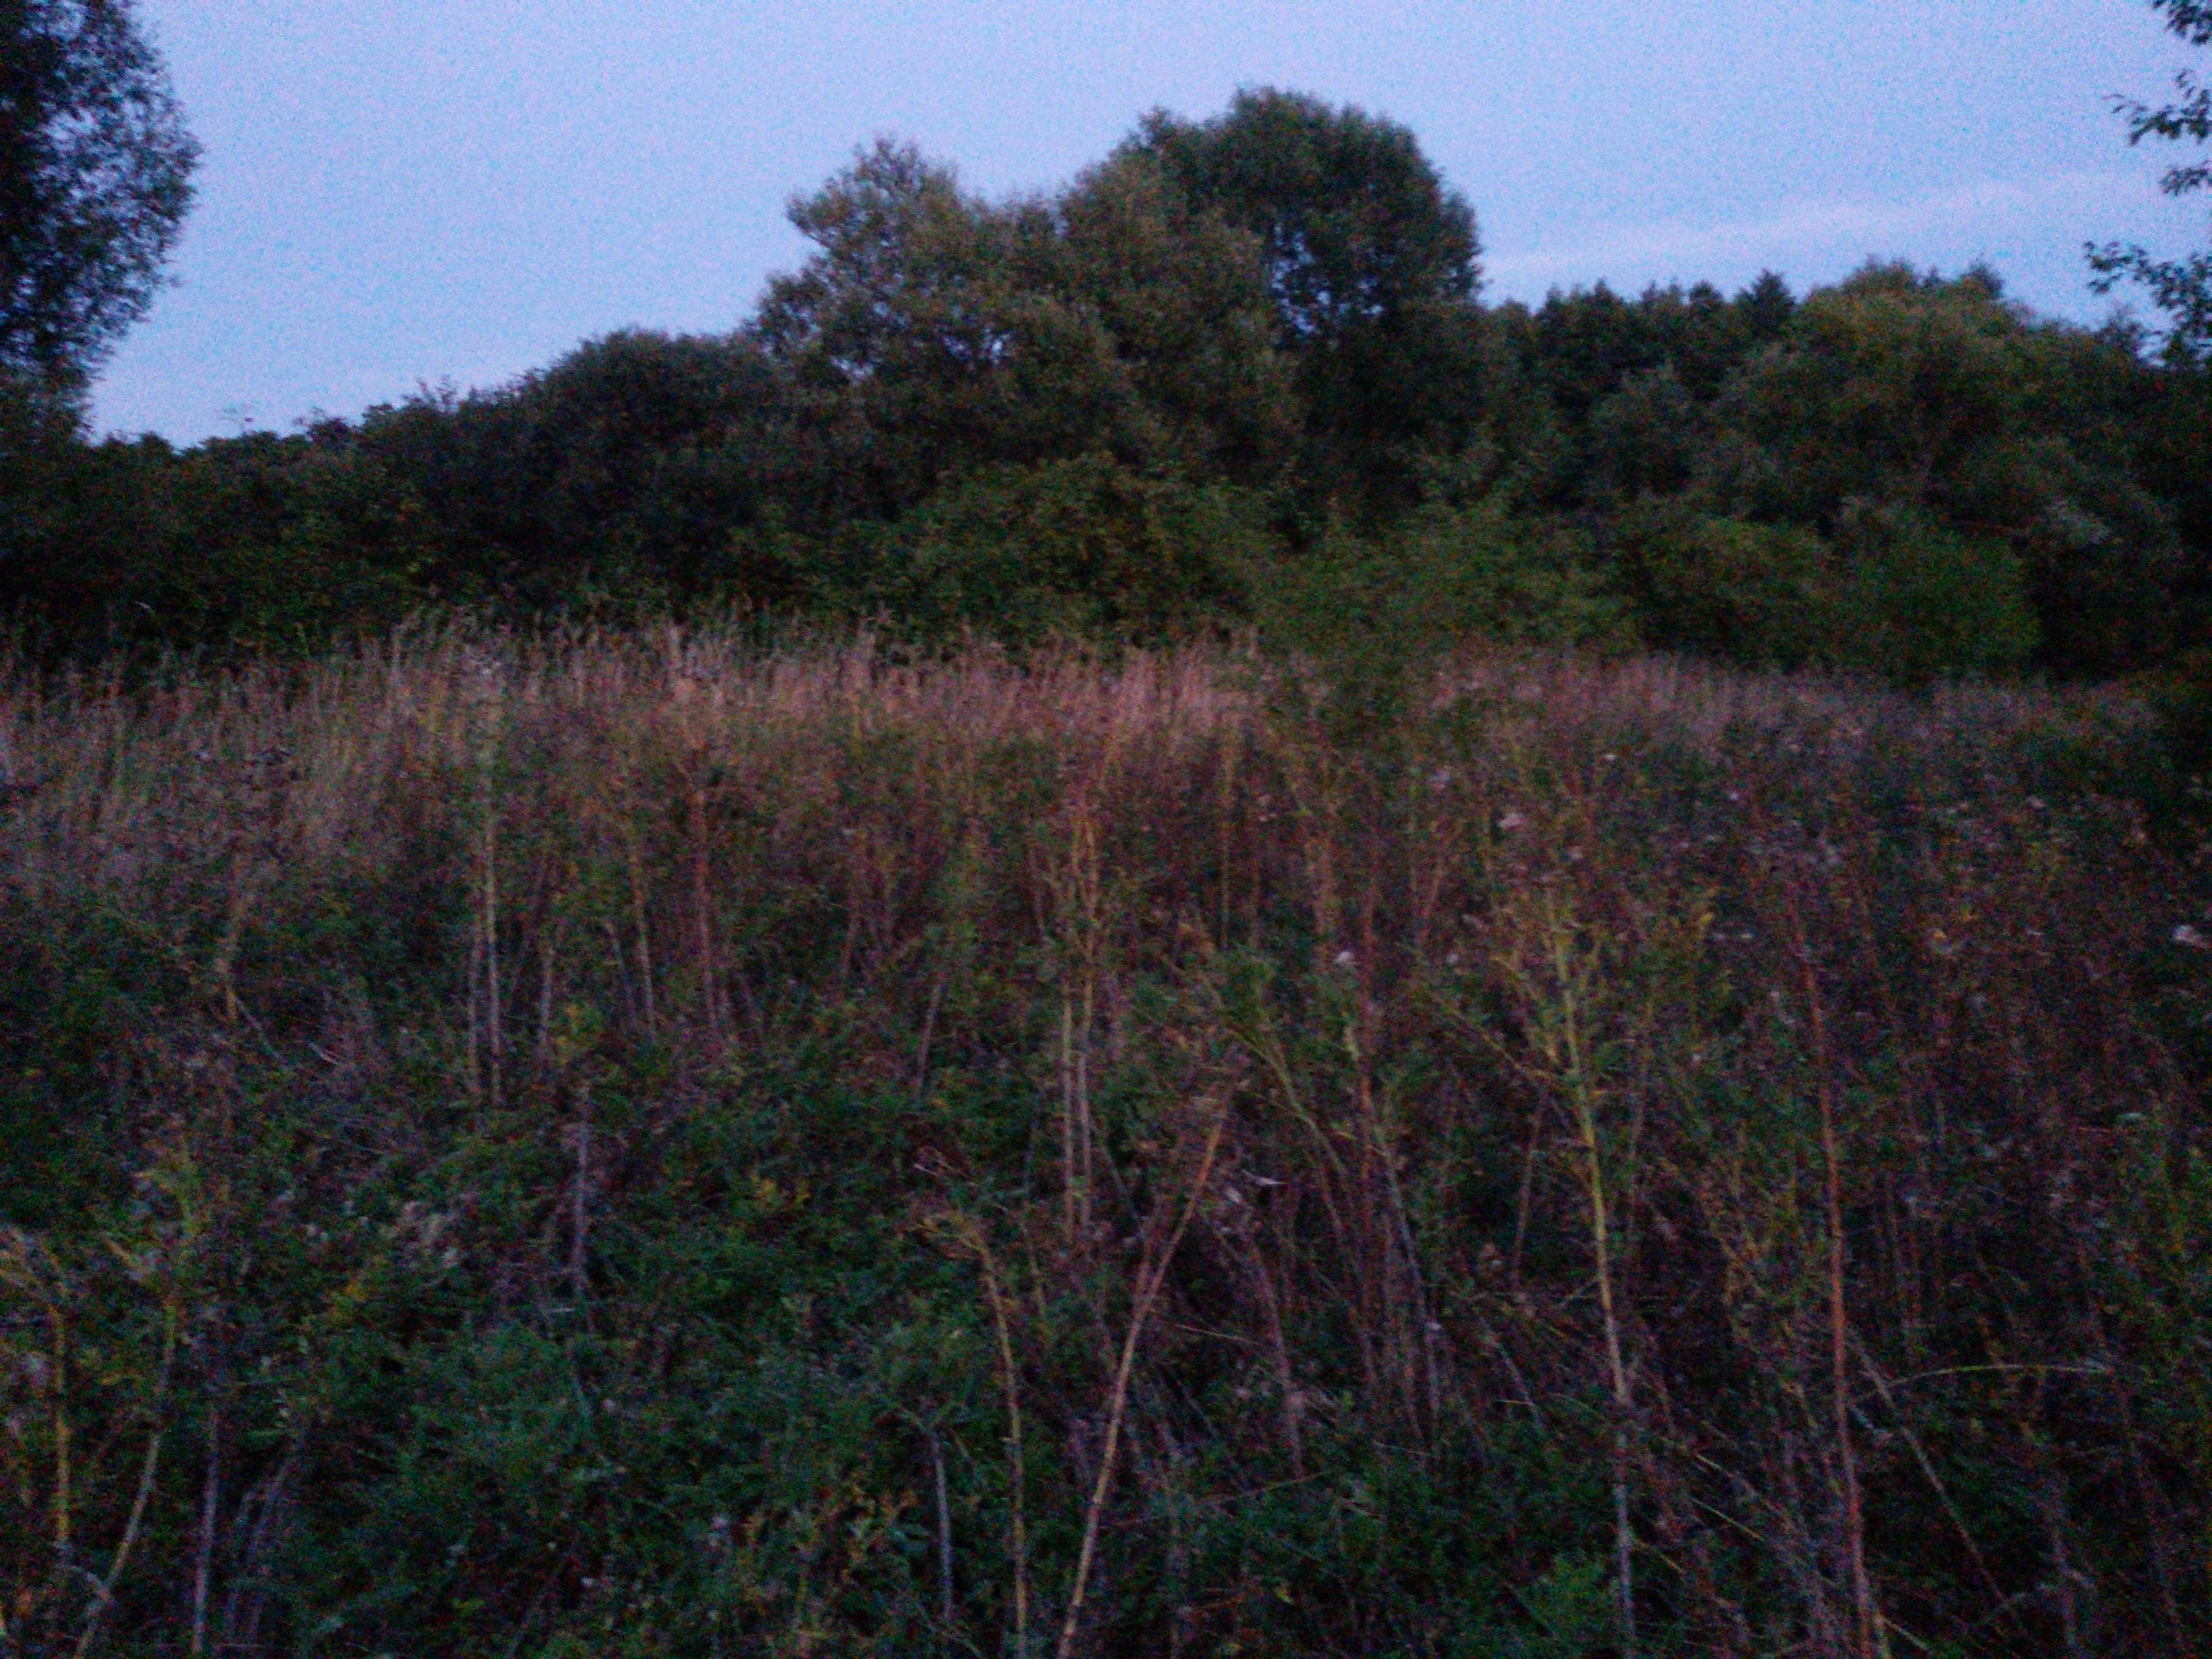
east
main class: Grassland
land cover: Spontaneously vegetated surfaces
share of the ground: > 75 %
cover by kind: herbaceous plants 100 %
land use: Semi-natural and natural areas not in use
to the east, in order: Spontaneously vegetated surfaces; Tracks; Broadleaved woodland; Ditches and canals; Broadleaved woodland; Spontaneously vegetated surfaces; Ditches and canals; Spontaneously vegetated surfaces; Broadleaved woodland; Rivers and streams; Broadleaved woodland
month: September
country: PL
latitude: 53.1435
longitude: 17.6224
